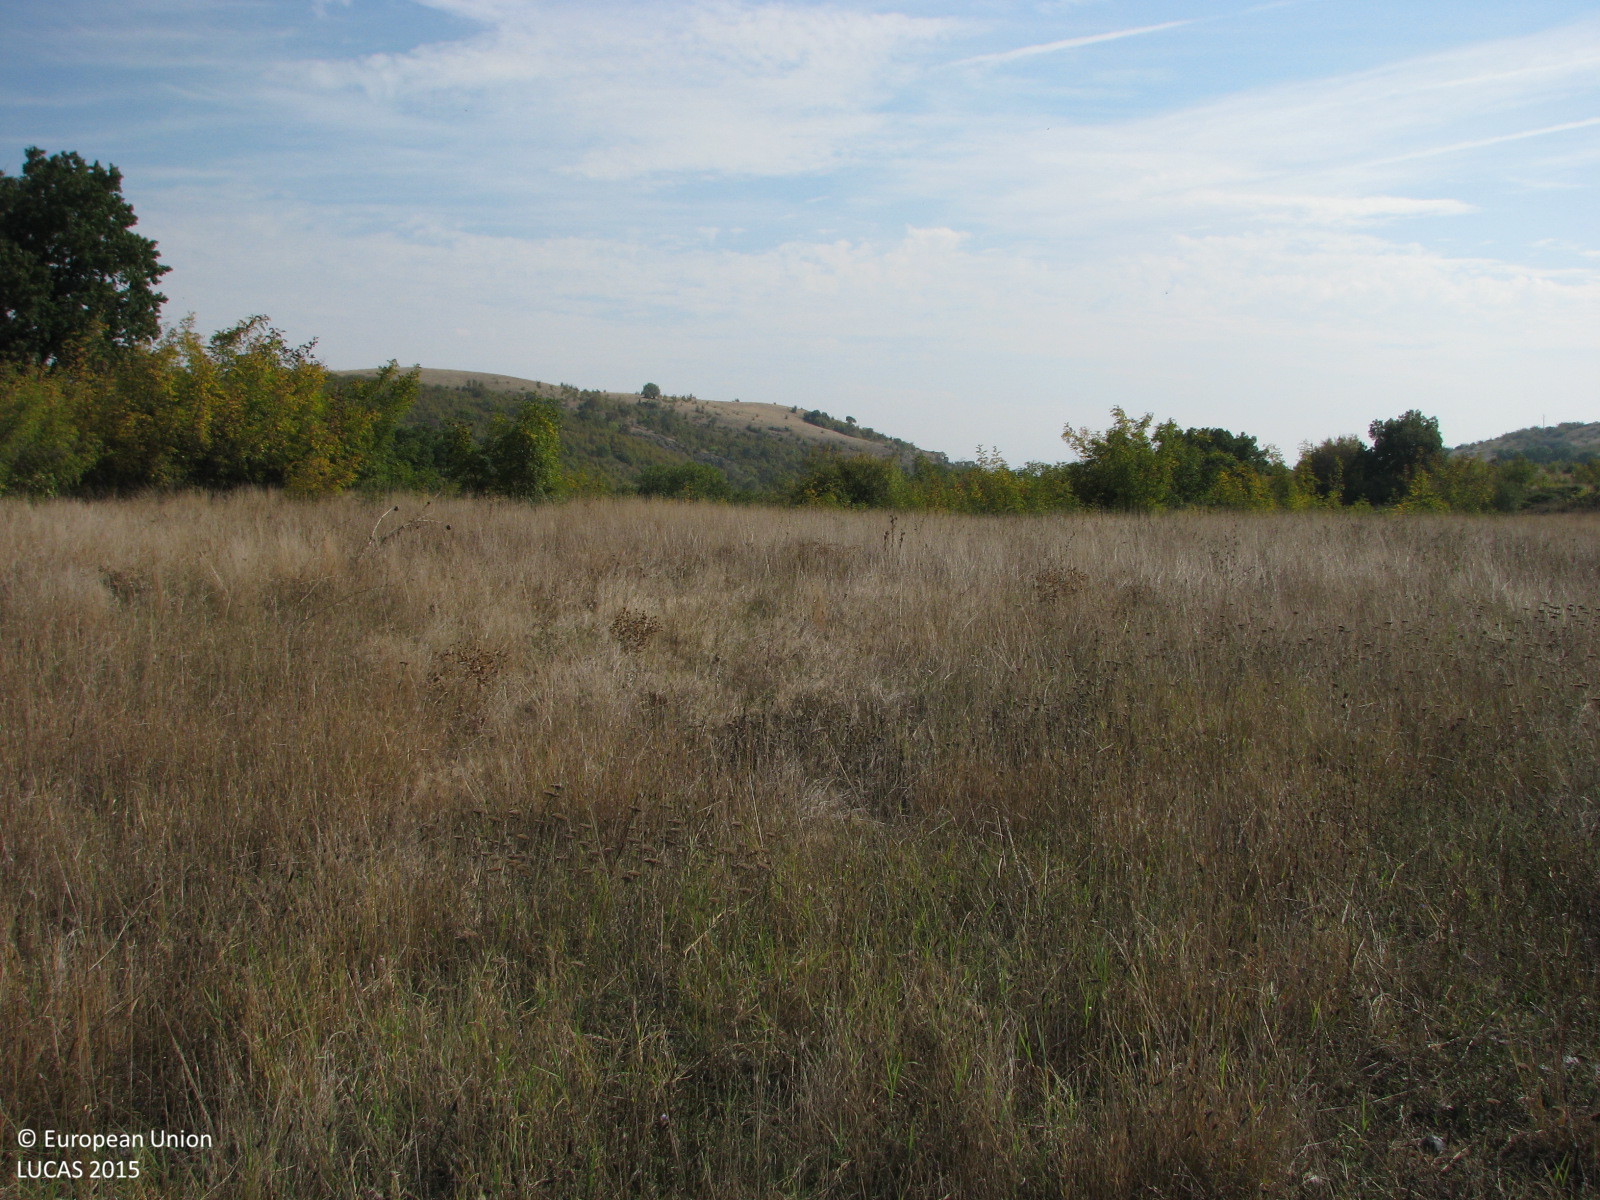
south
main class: Grassland
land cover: Grassland without tree/shrub cover
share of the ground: > 75 %
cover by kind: herbaceous plants 100 %
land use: Agriculture (excluding fallow land and kitchen gardens)
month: October
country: BG
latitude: 42.5287
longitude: 25.8930
